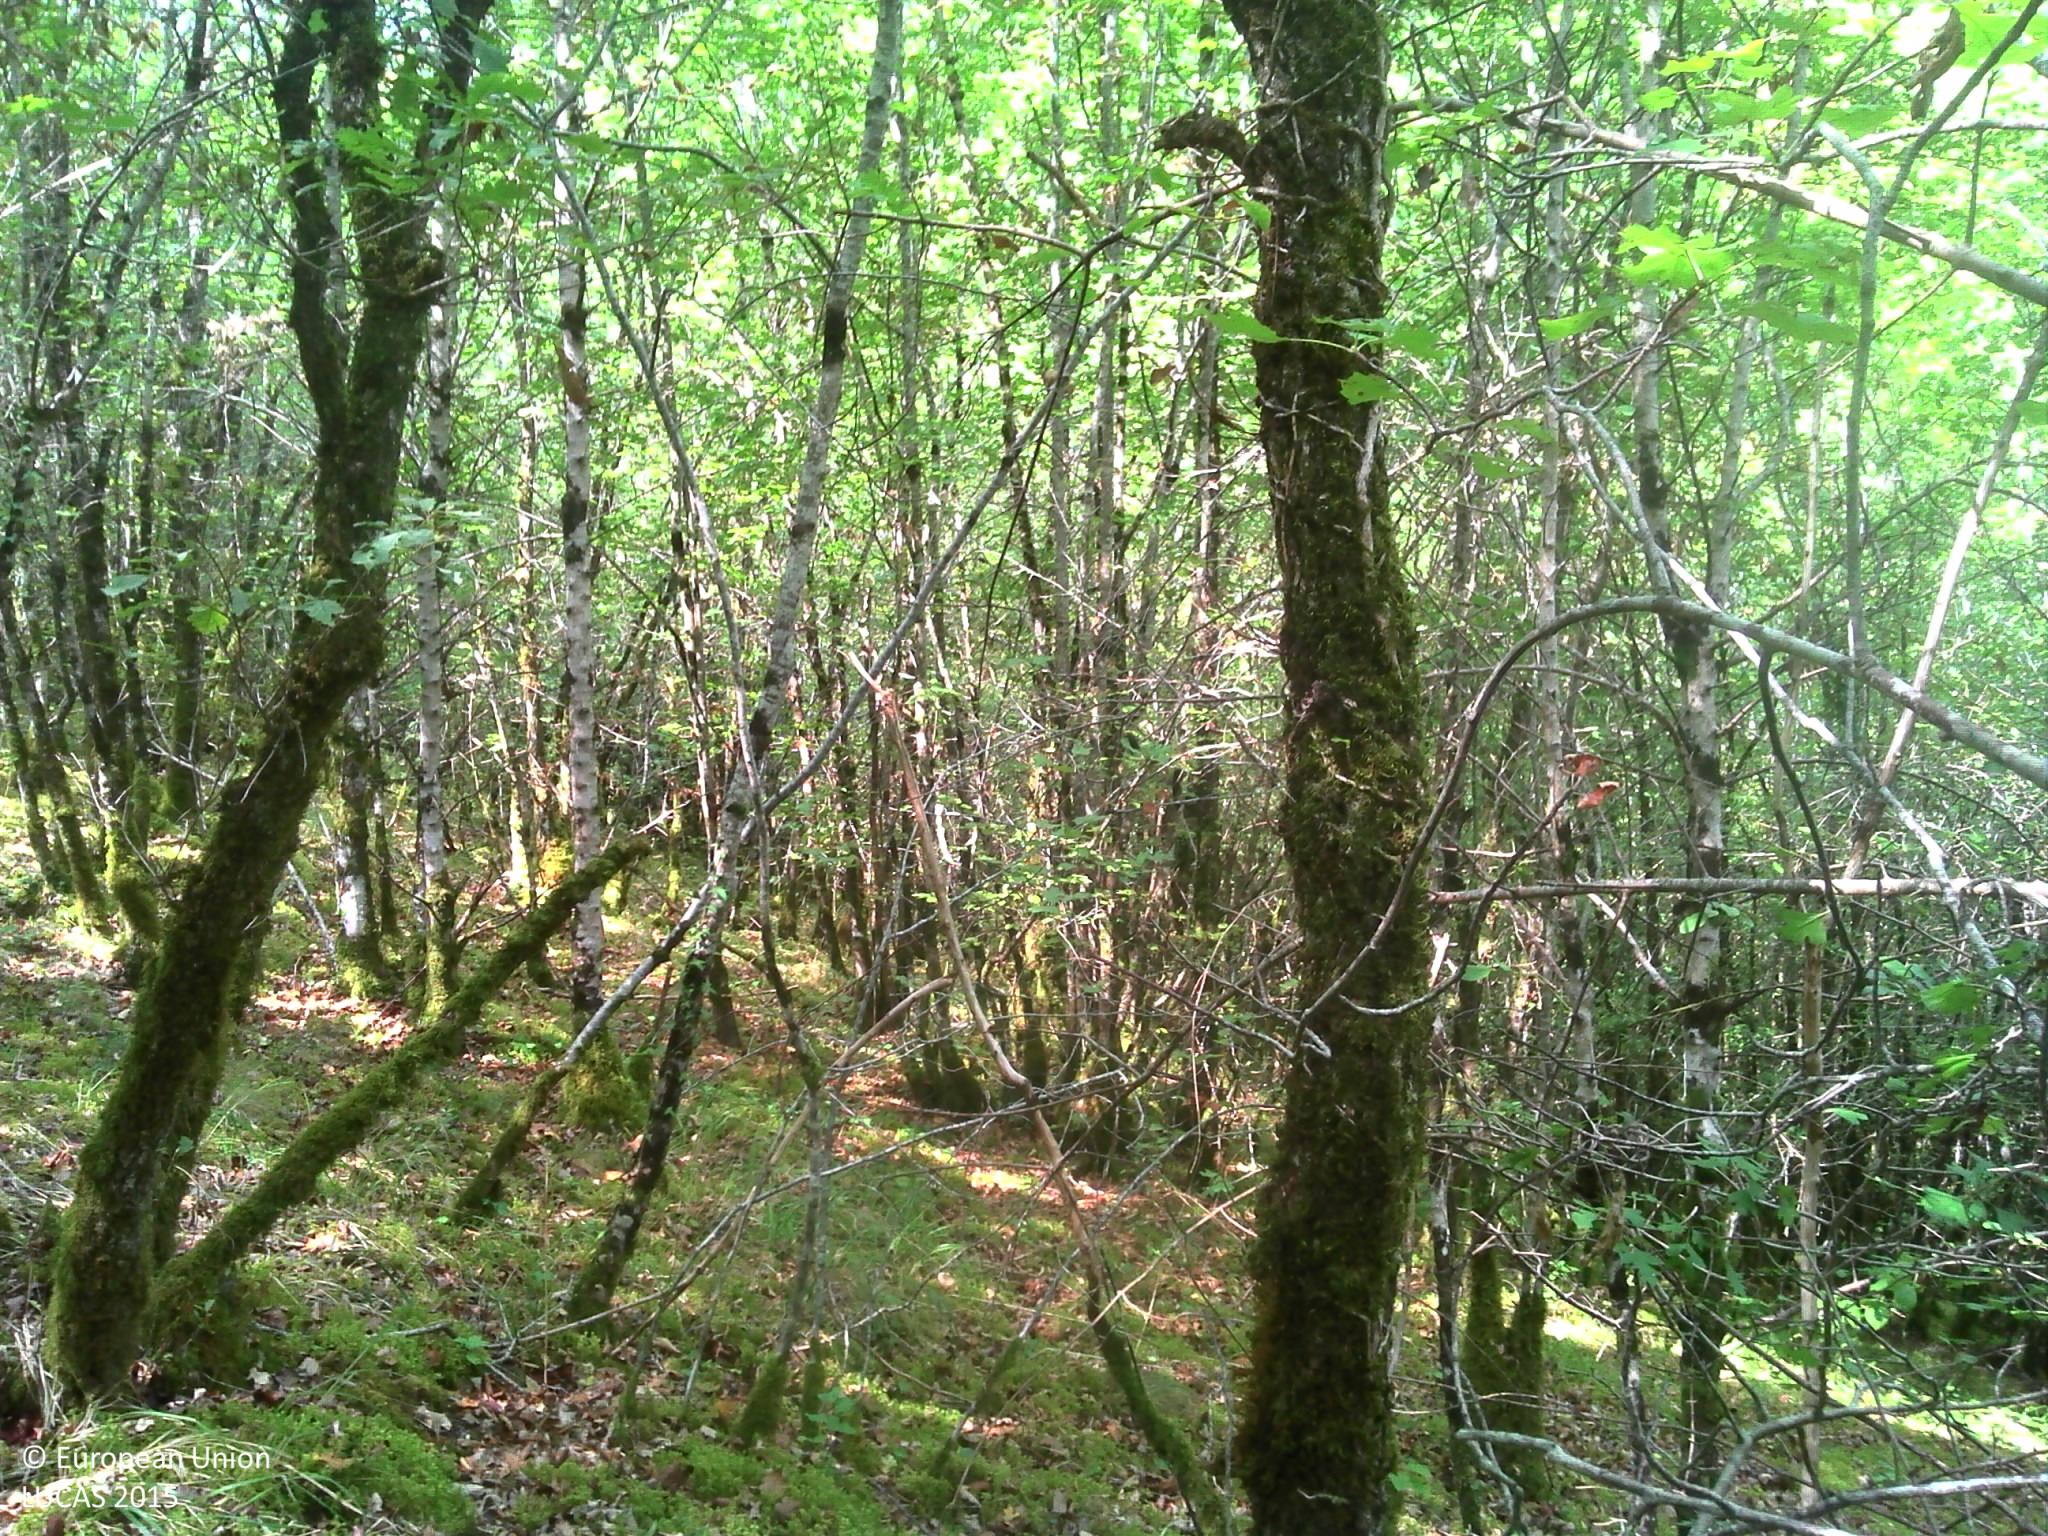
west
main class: Woodland
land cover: Broadleaved woodland
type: acidophilous oak and oak-birch forest
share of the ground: > 75 %
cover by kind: broadleaved forest trees 80 %, herbaceous plants 10 %, lichens and mosses 10 %
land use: Forestry
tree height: > 5 m
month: August
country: FR
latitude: 44.9211
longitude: 1.4447
